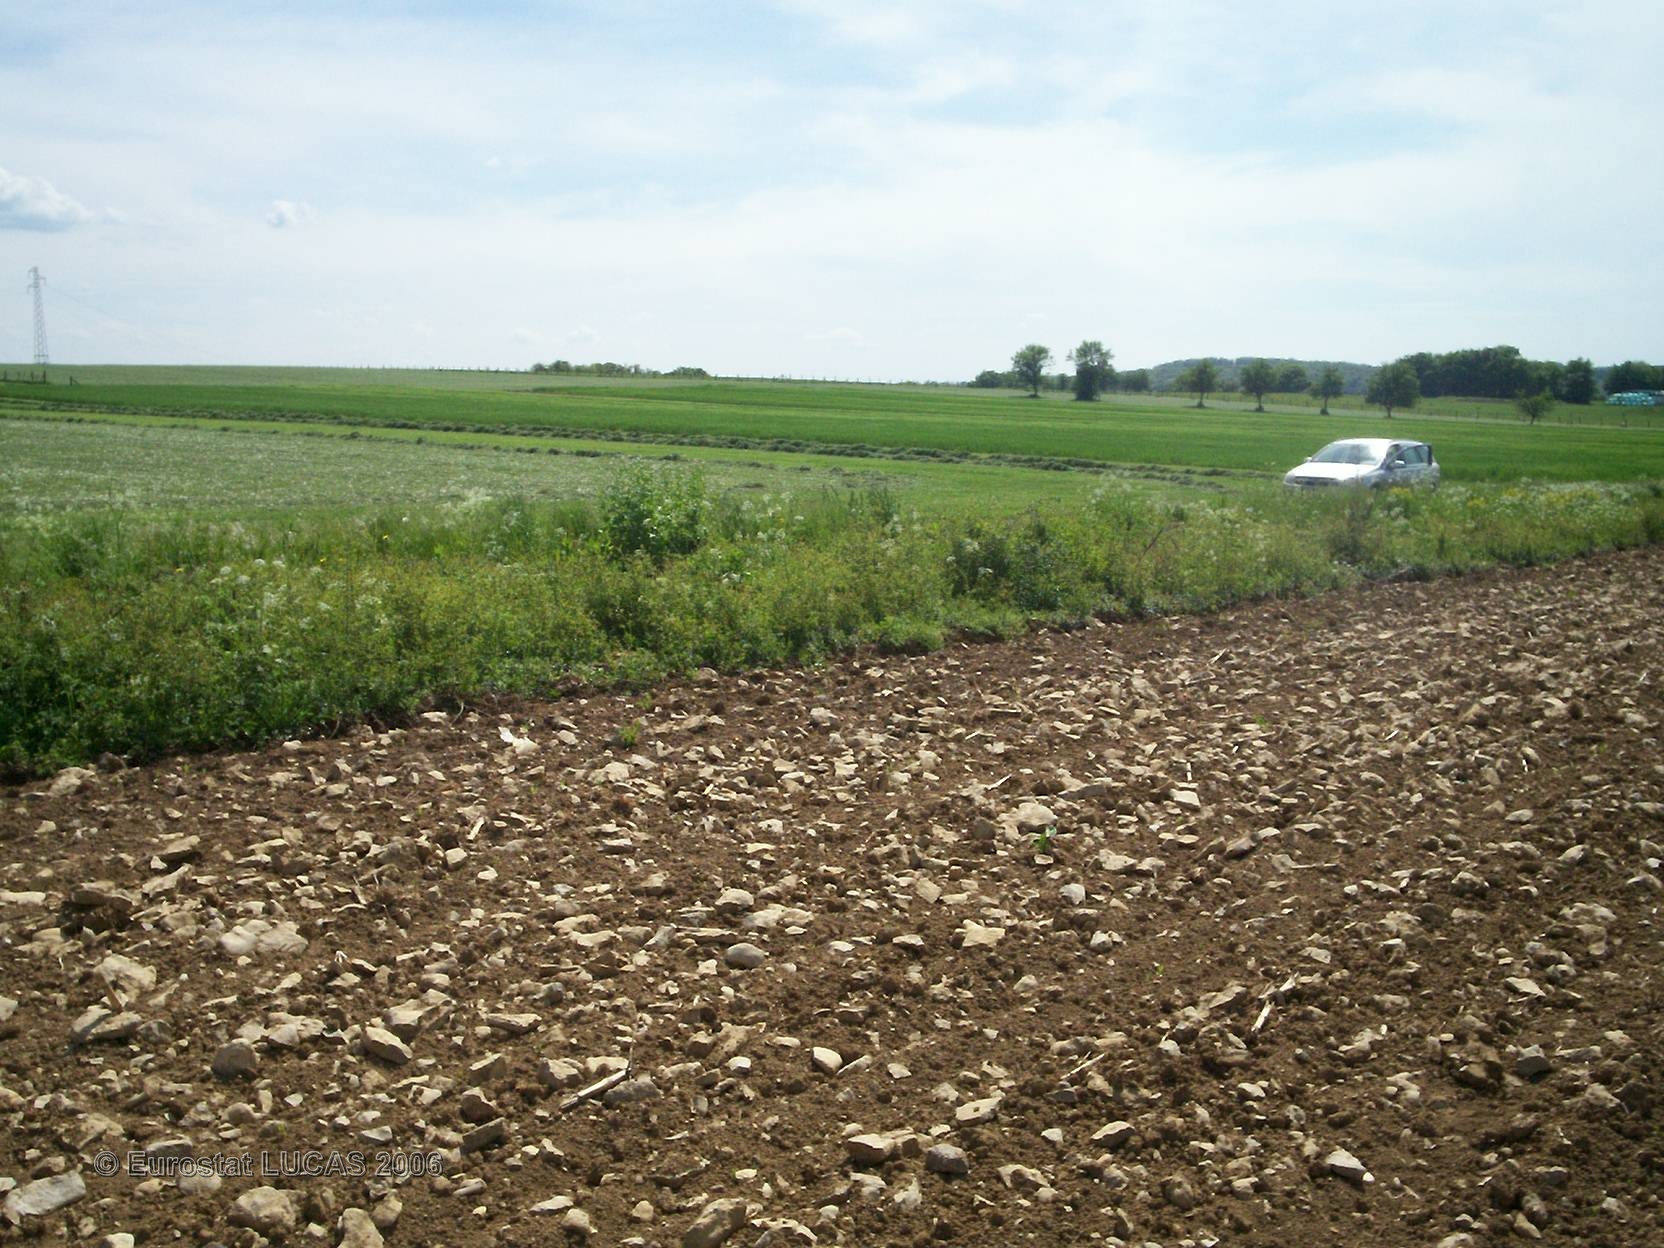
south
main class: Cropland
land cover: Maize
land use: Agriculture (excluding fallow land and kitchen gardens)
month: May
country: FR
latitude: 48.7789
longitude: 7.0747
